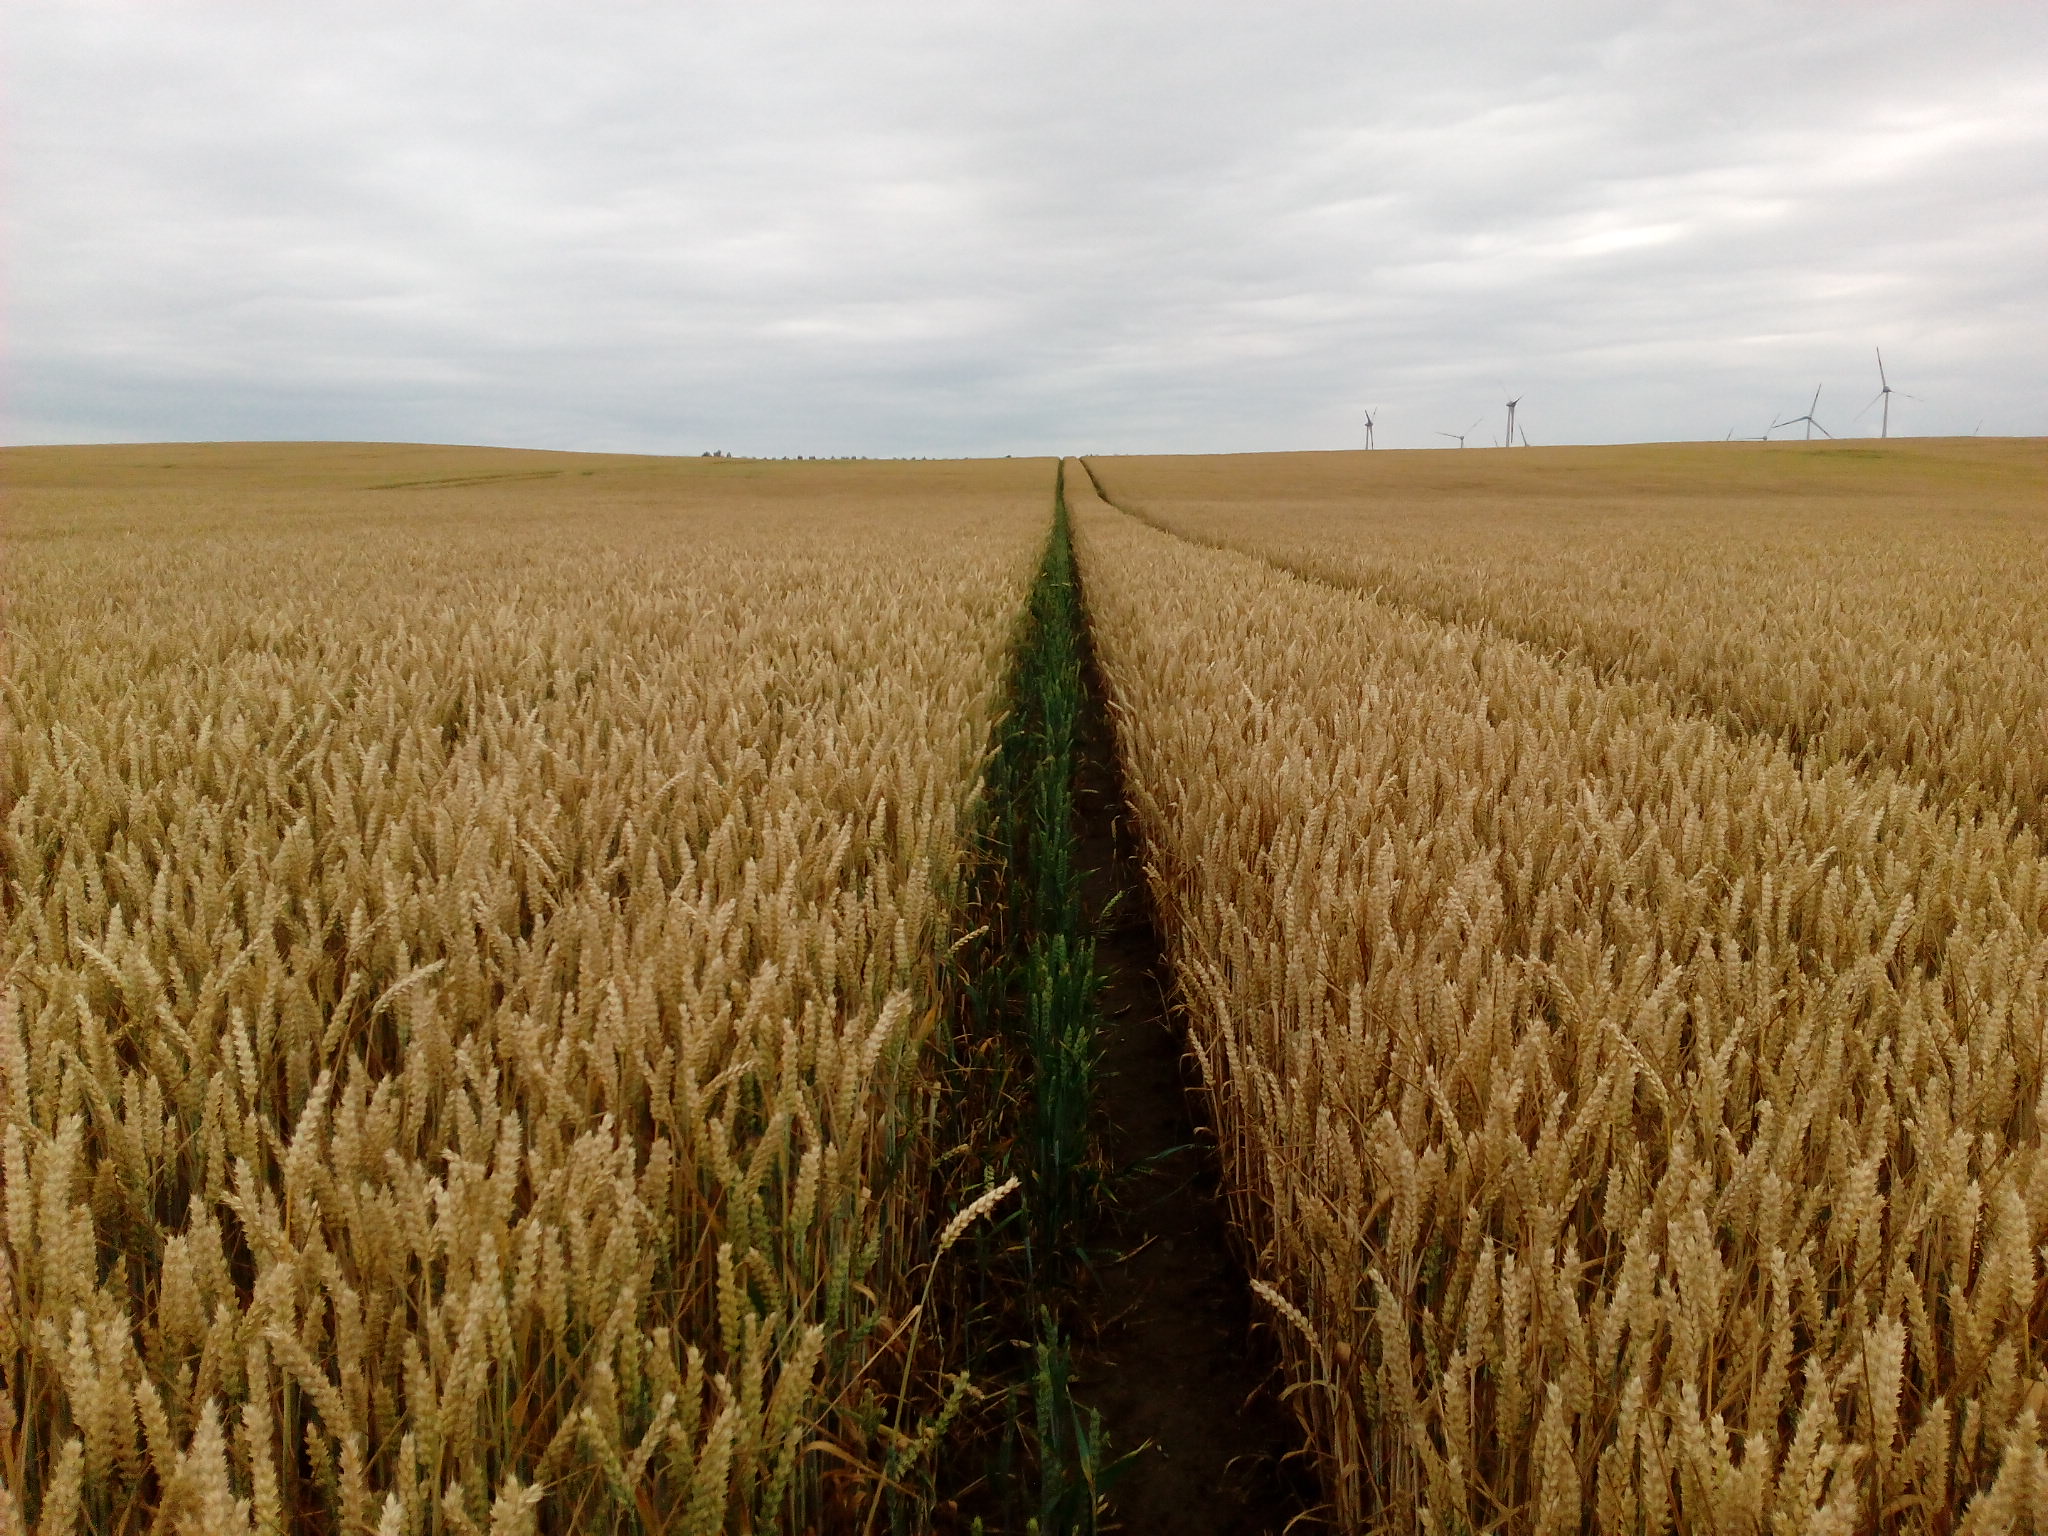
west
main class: Cropland
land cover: Common wheat
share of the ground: > 75 %
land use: Agriculture (excluding fallow land and kitchen gardens)
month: July
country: DE
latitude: 53.3833
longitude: 14.1952
